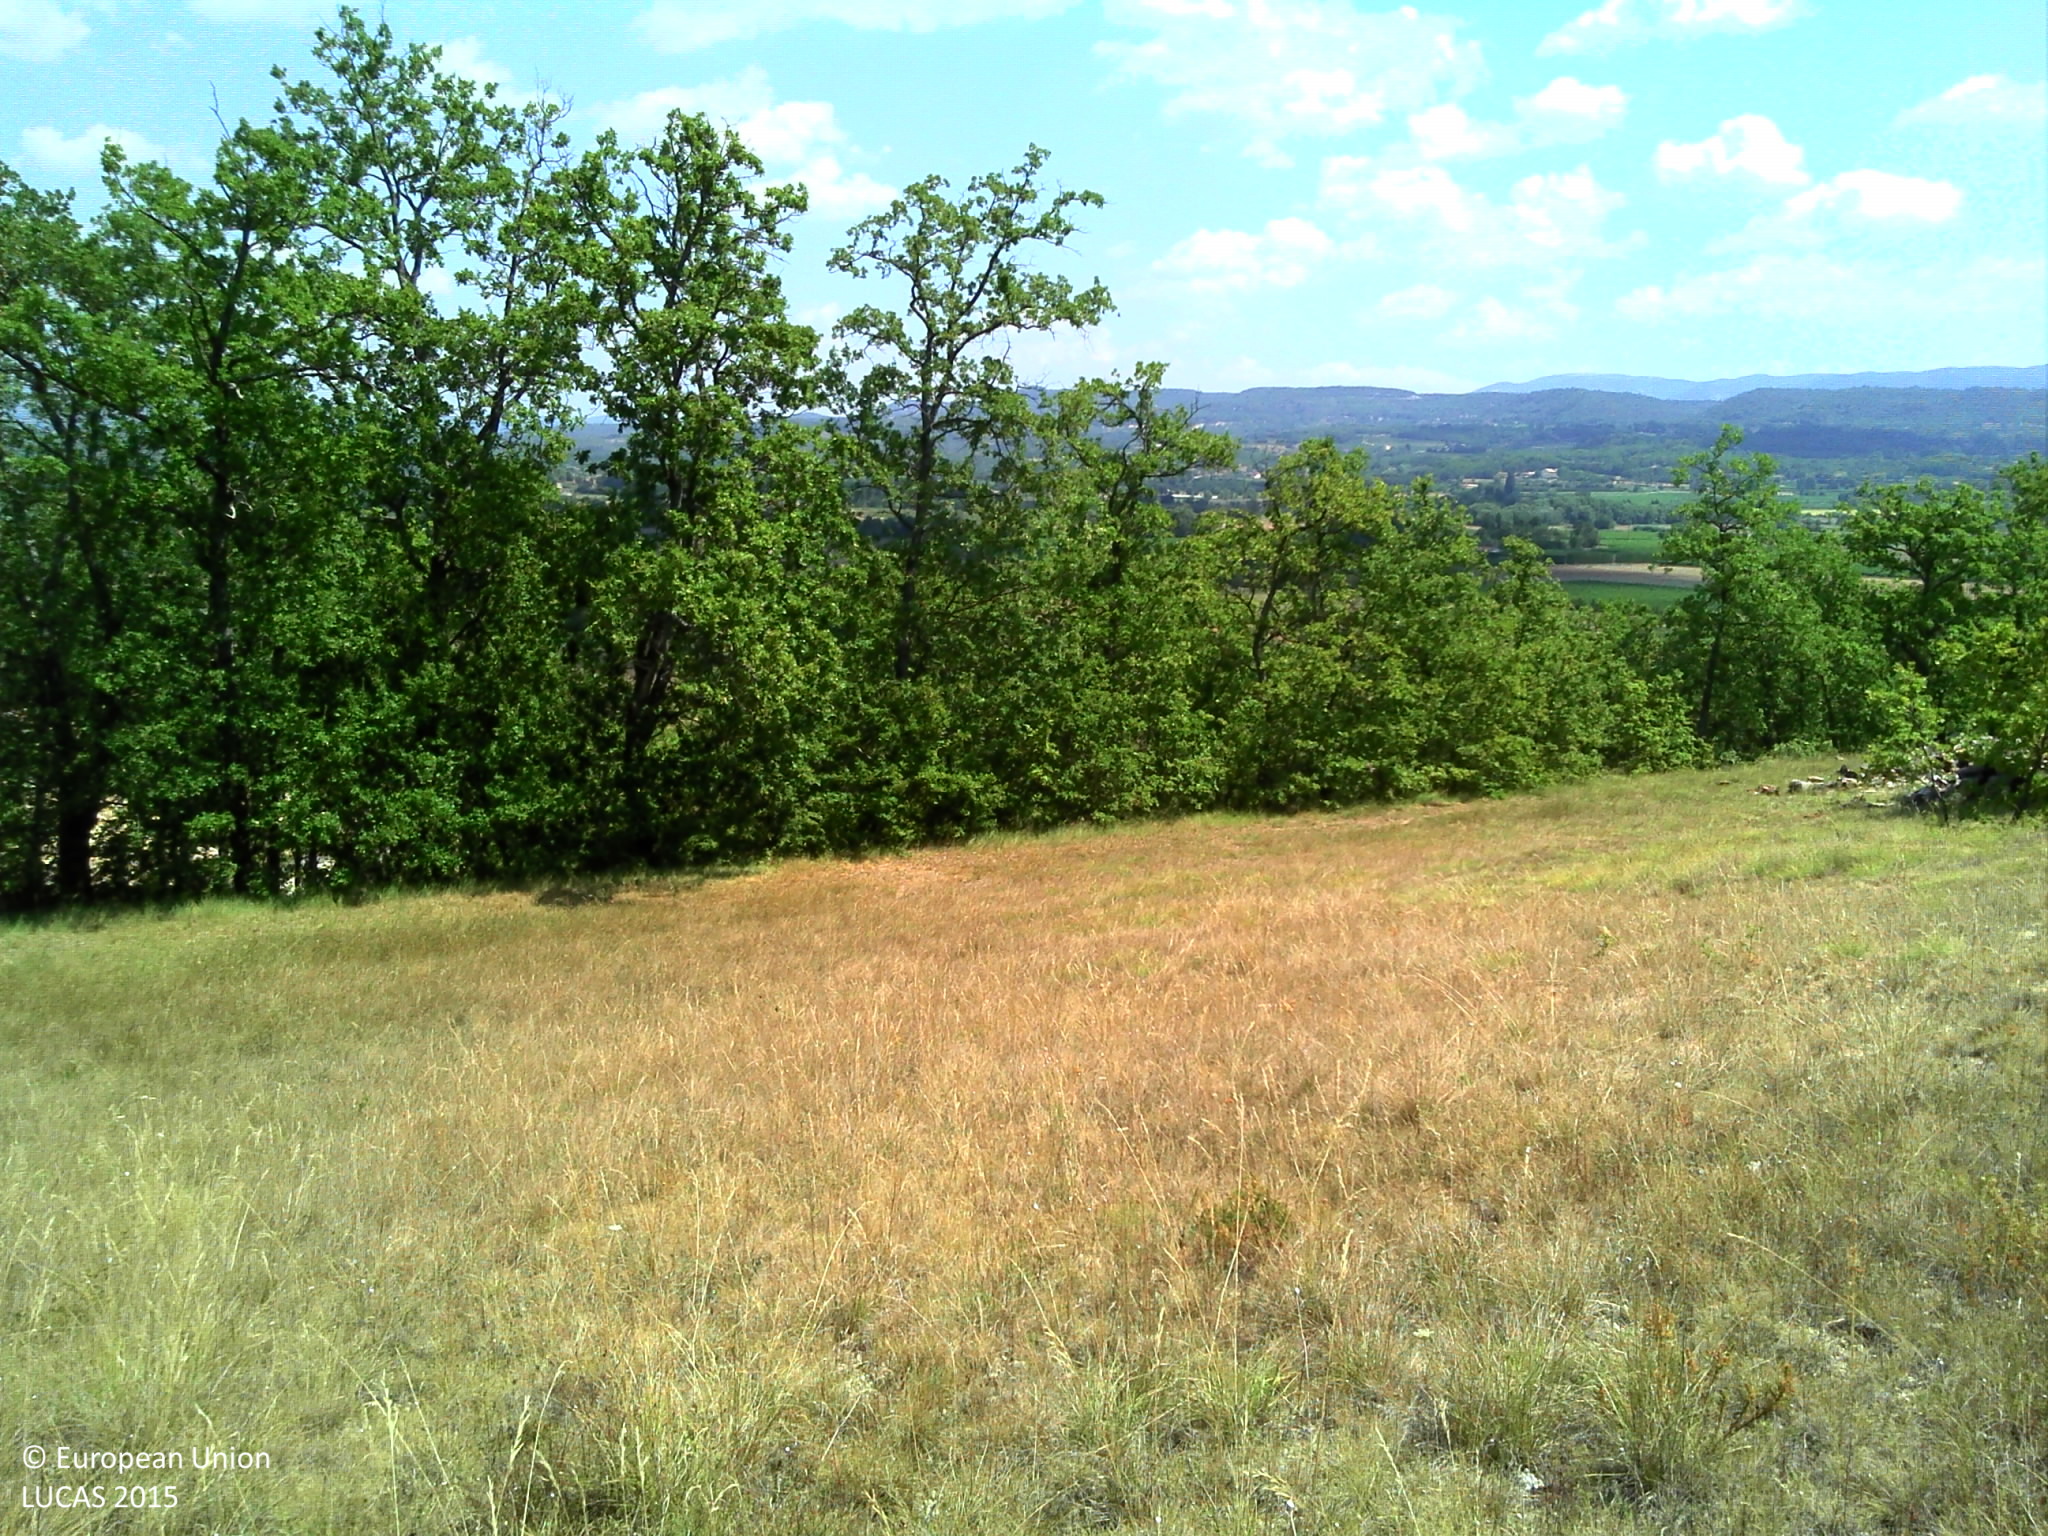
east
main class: Grassland
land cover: Spontaneously vegetated surfaces
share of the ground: > 75 %
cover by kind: herbaceous plants 95 %, lichens and mosses 5 %
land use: Semi-natural and natural areas not in use
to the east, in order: Spontaneously vegetated surfaces; Broadleaved woodland; Tracks; Grassland without tree/shrub cover; Vineyards; Managed hedges; Vineyards; Managed hedges; Tracks; Grassland without tree/shrub cover; Managed hedges; Vineyards
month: August
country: FR
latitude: 43.8452
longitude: 5.2697
